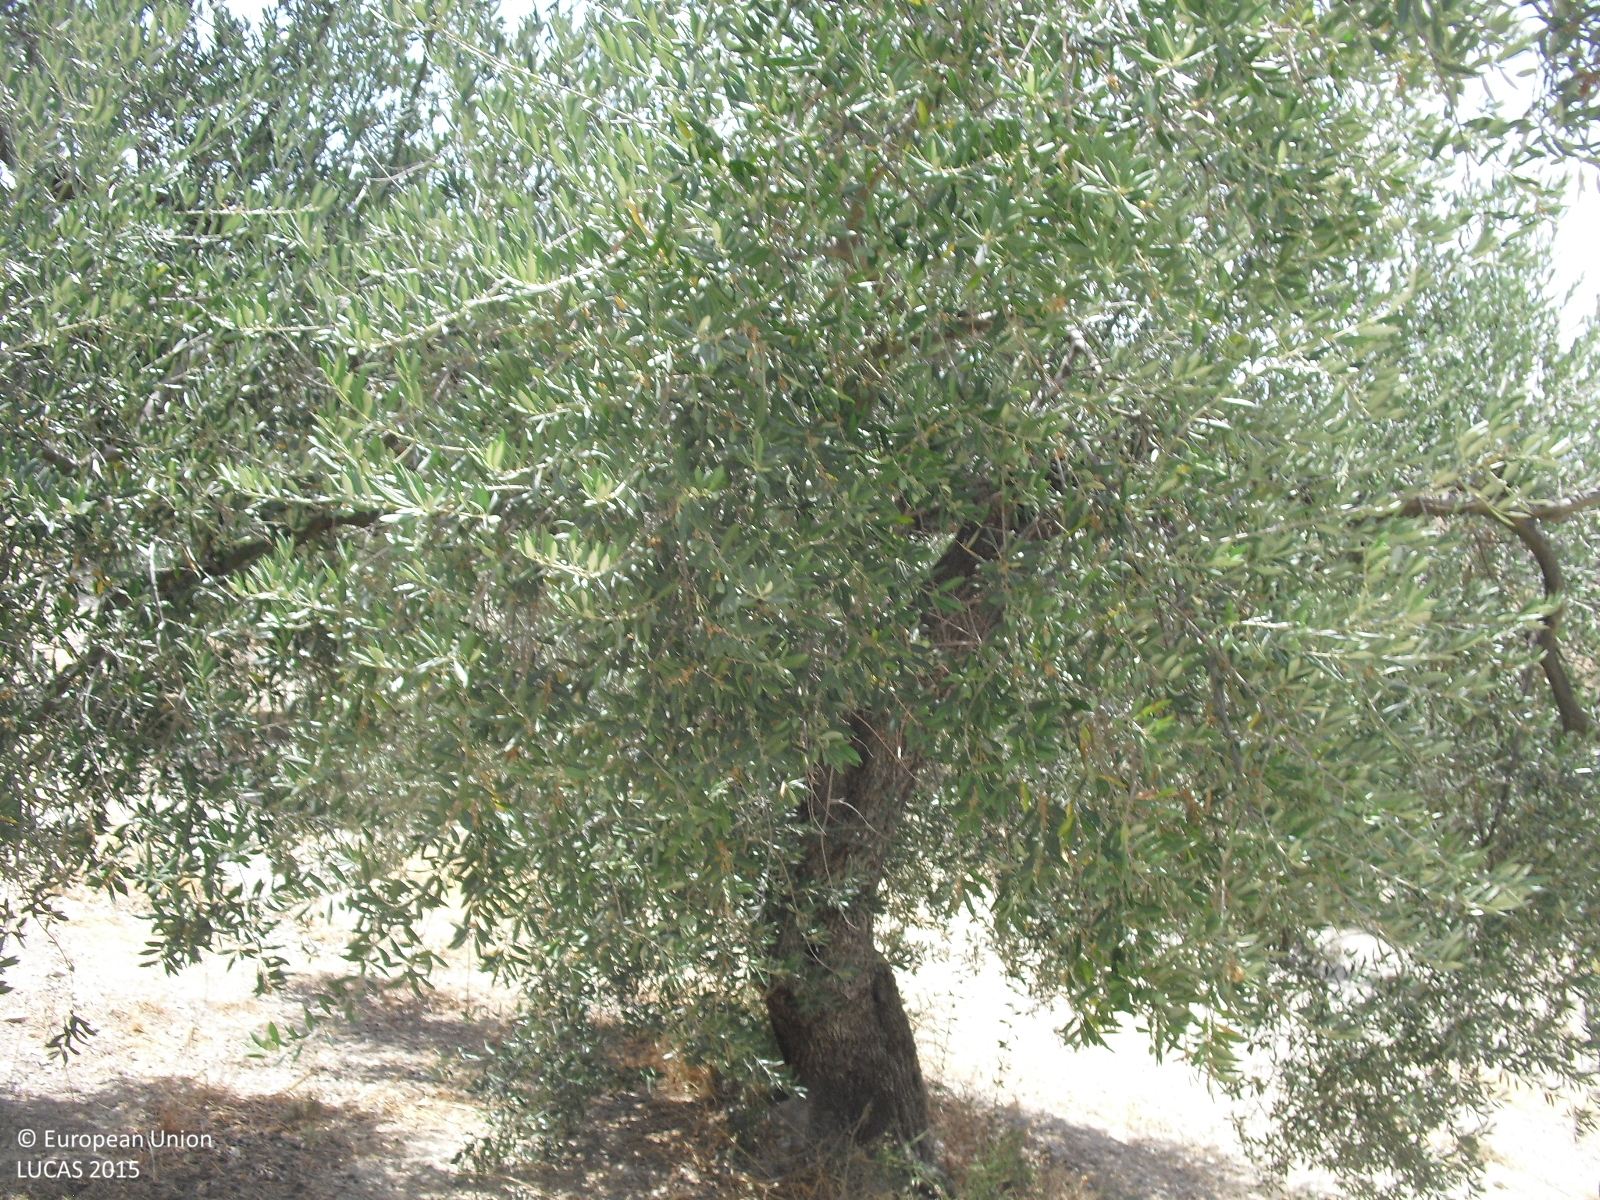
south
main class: Cropland
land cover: Olive groves
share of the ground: 25 - 50 %
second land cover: Other bare soil
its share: > 75 %
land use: Agriculture (excluding fallow land and kitchen gardens)
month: August
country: ES
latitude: 37.3576
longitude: -4.1900
